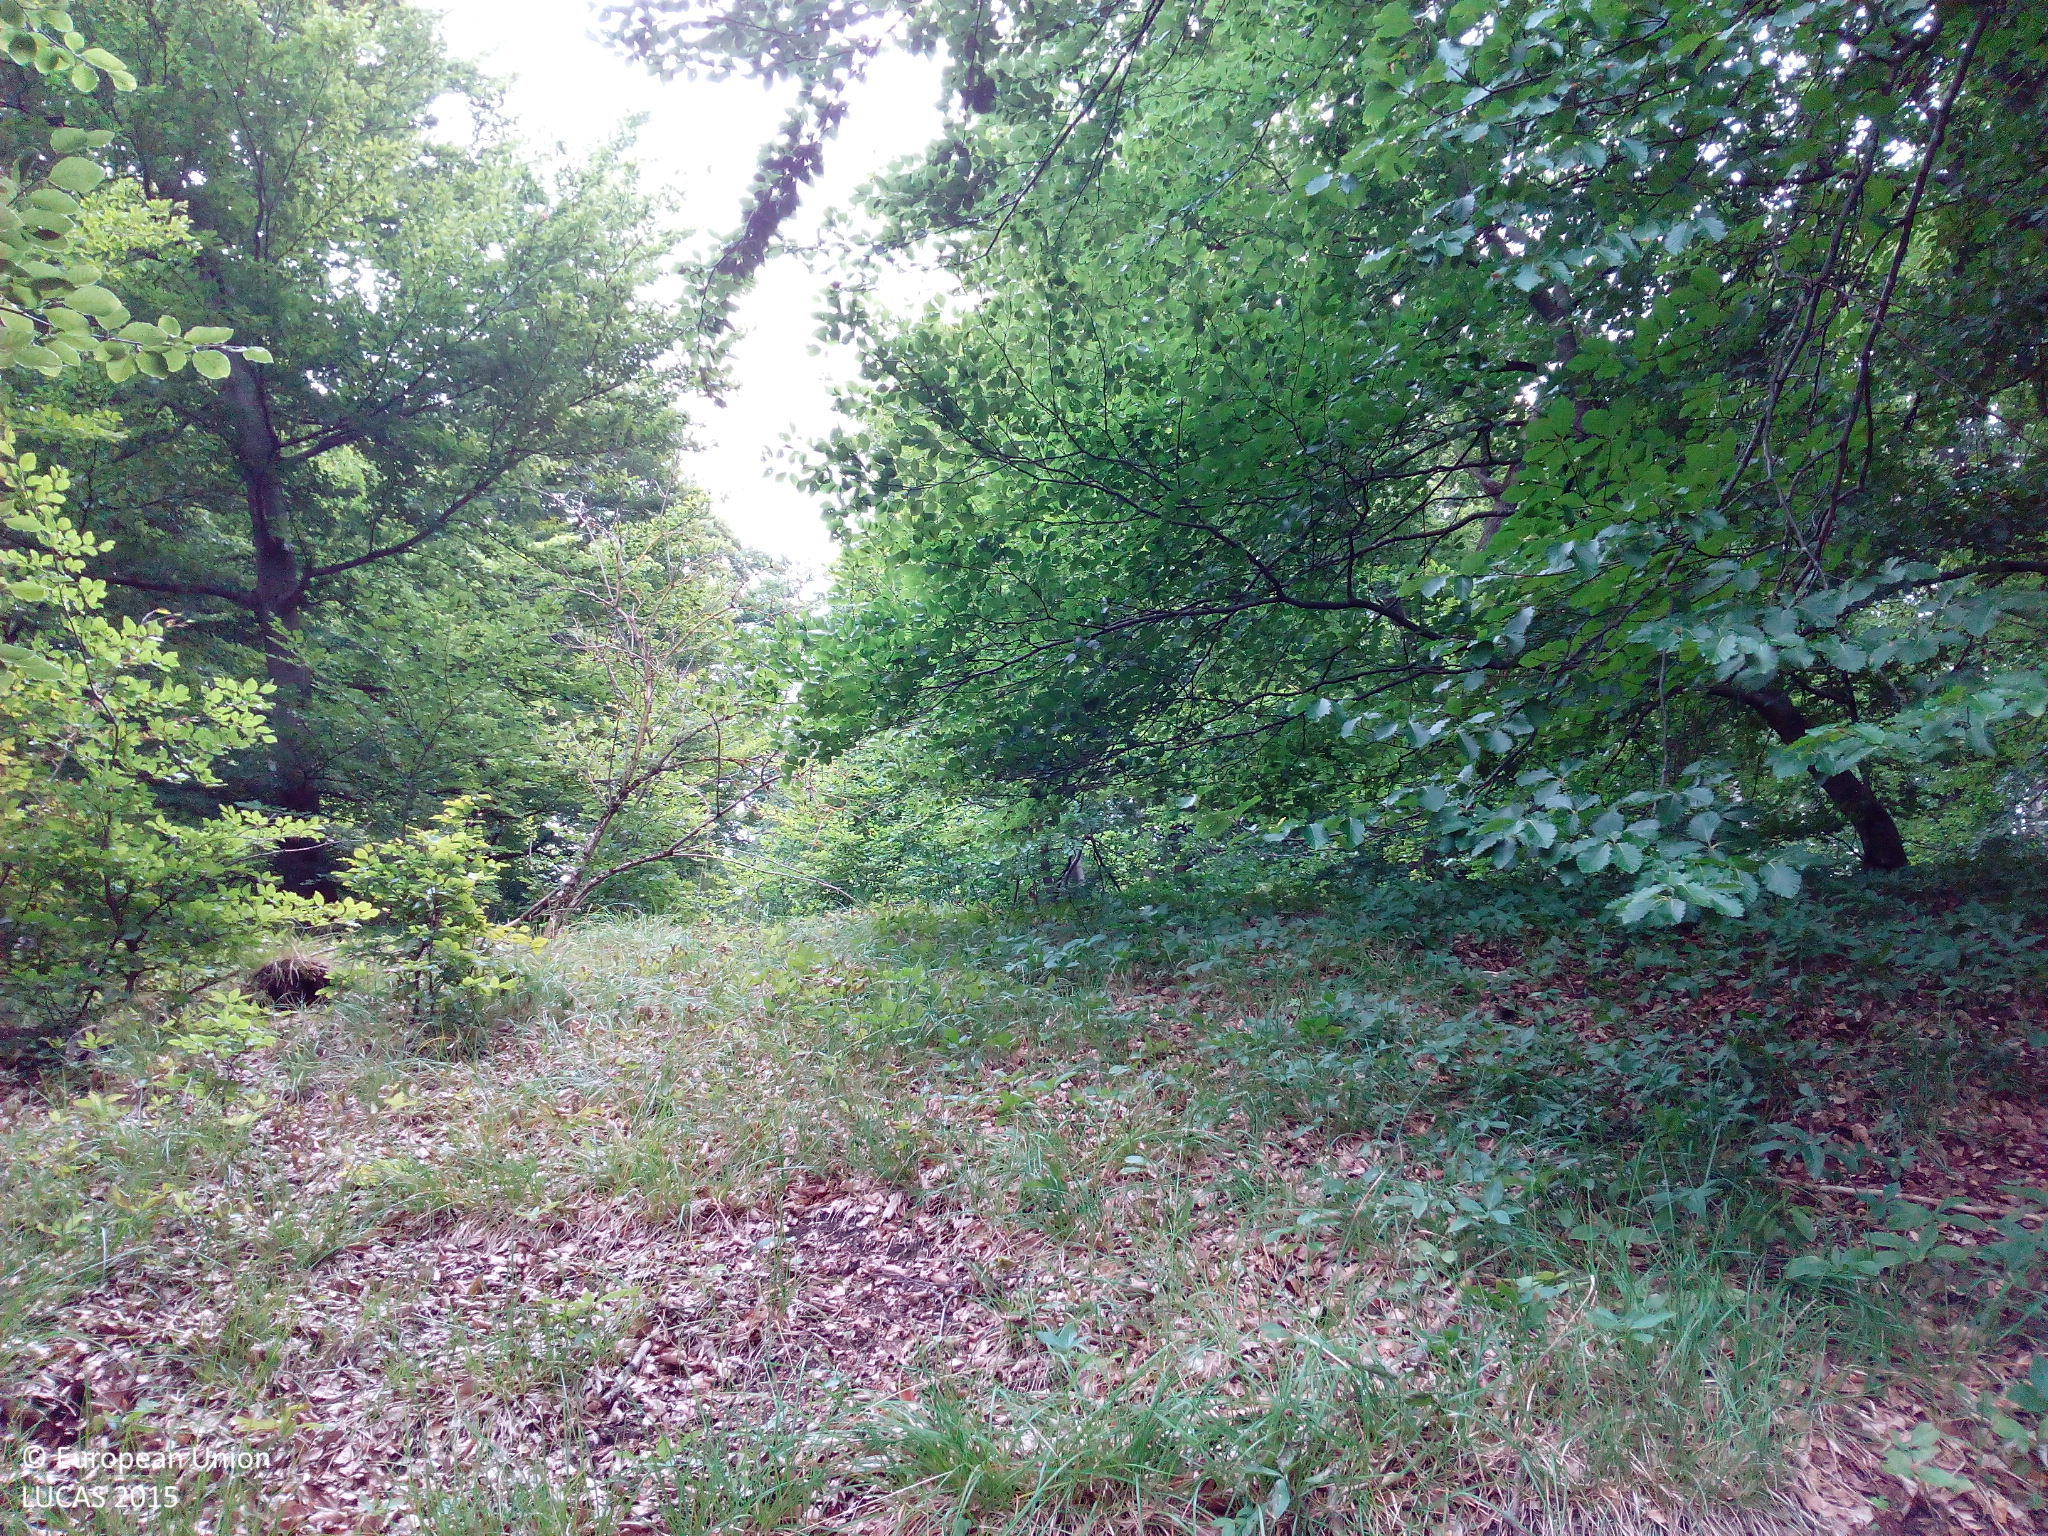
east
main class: Woodland
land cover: Broadleaved woodland
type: beech forest
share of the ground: > 75 %
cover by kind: broadleaved forest trees 75 %, unconsolidated bare surface 15 %, herbaceous plants 10 %
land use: Forestry
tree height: > 5 m
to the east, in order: Broadleaved woodland
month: July
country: DE
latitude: 48.8528
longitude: 10.3133
